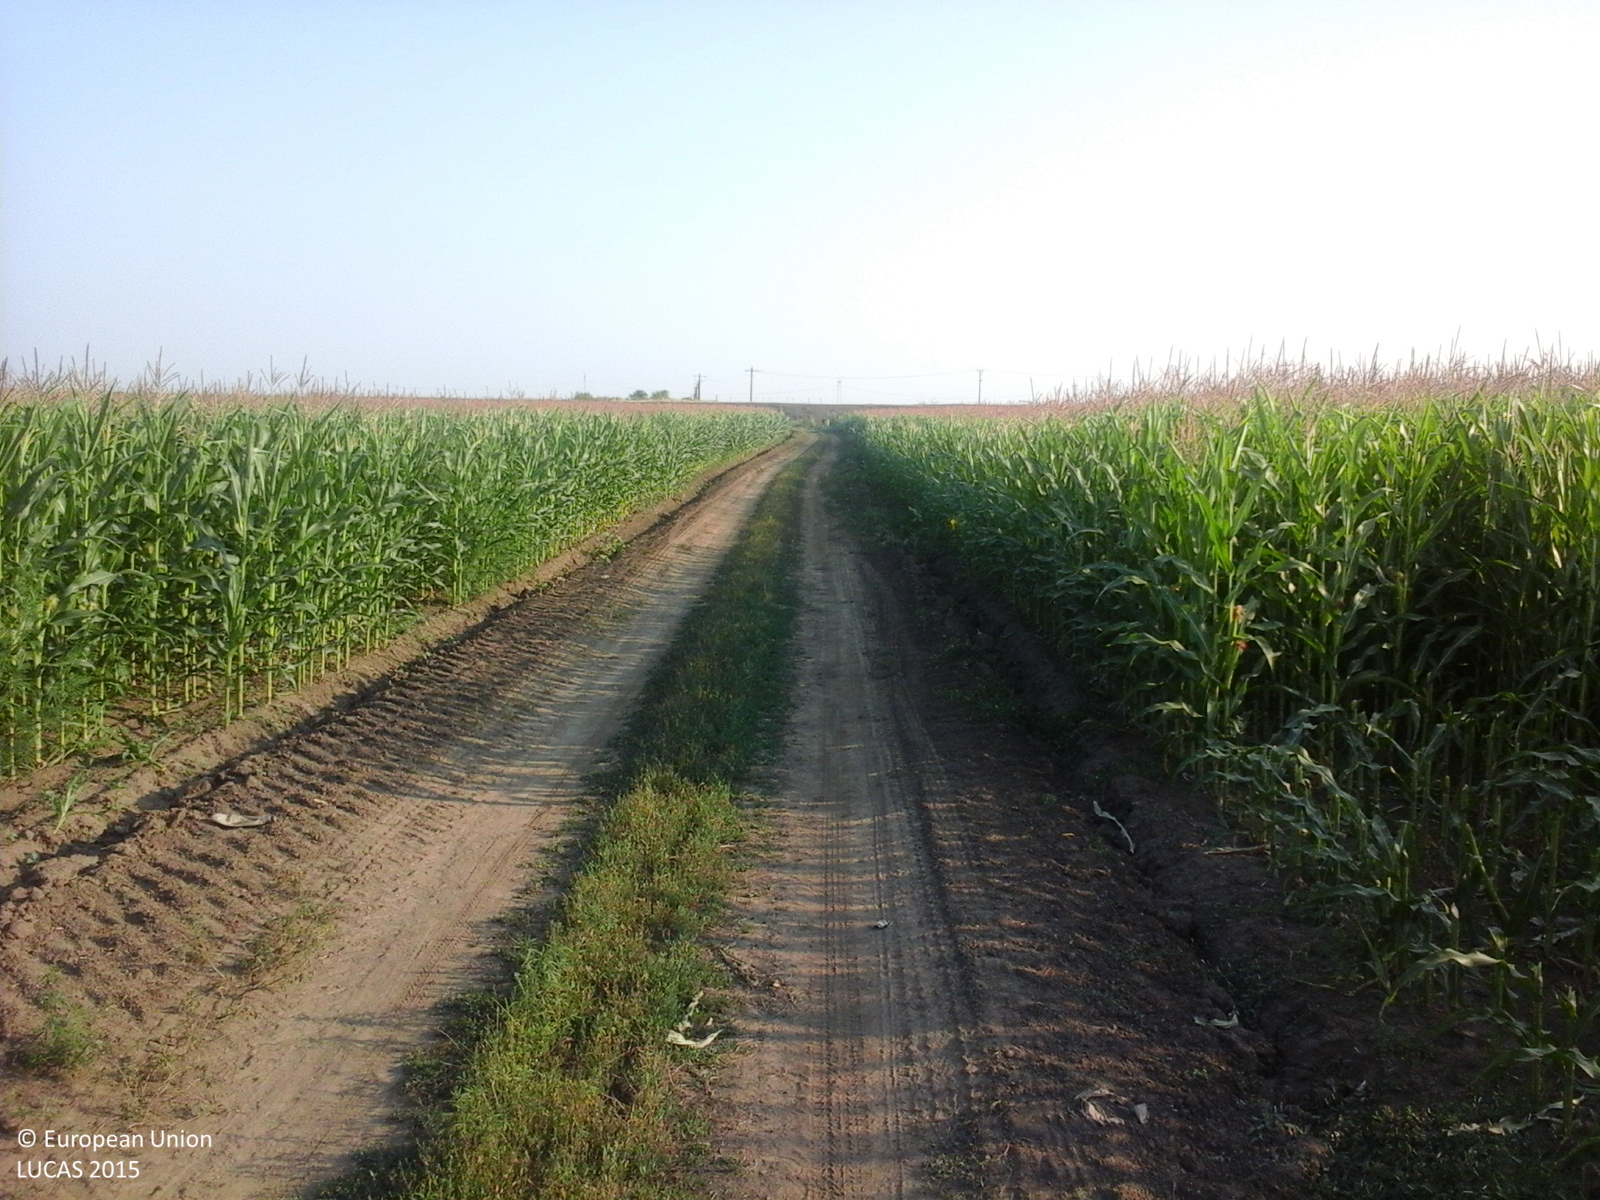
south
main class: Cropland
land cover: Maize
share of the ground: > 75 %
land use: Agriculture (excluding fallow land and kitchen gardens)
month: July
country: RO
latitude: 44.6556
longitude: 27.2760
